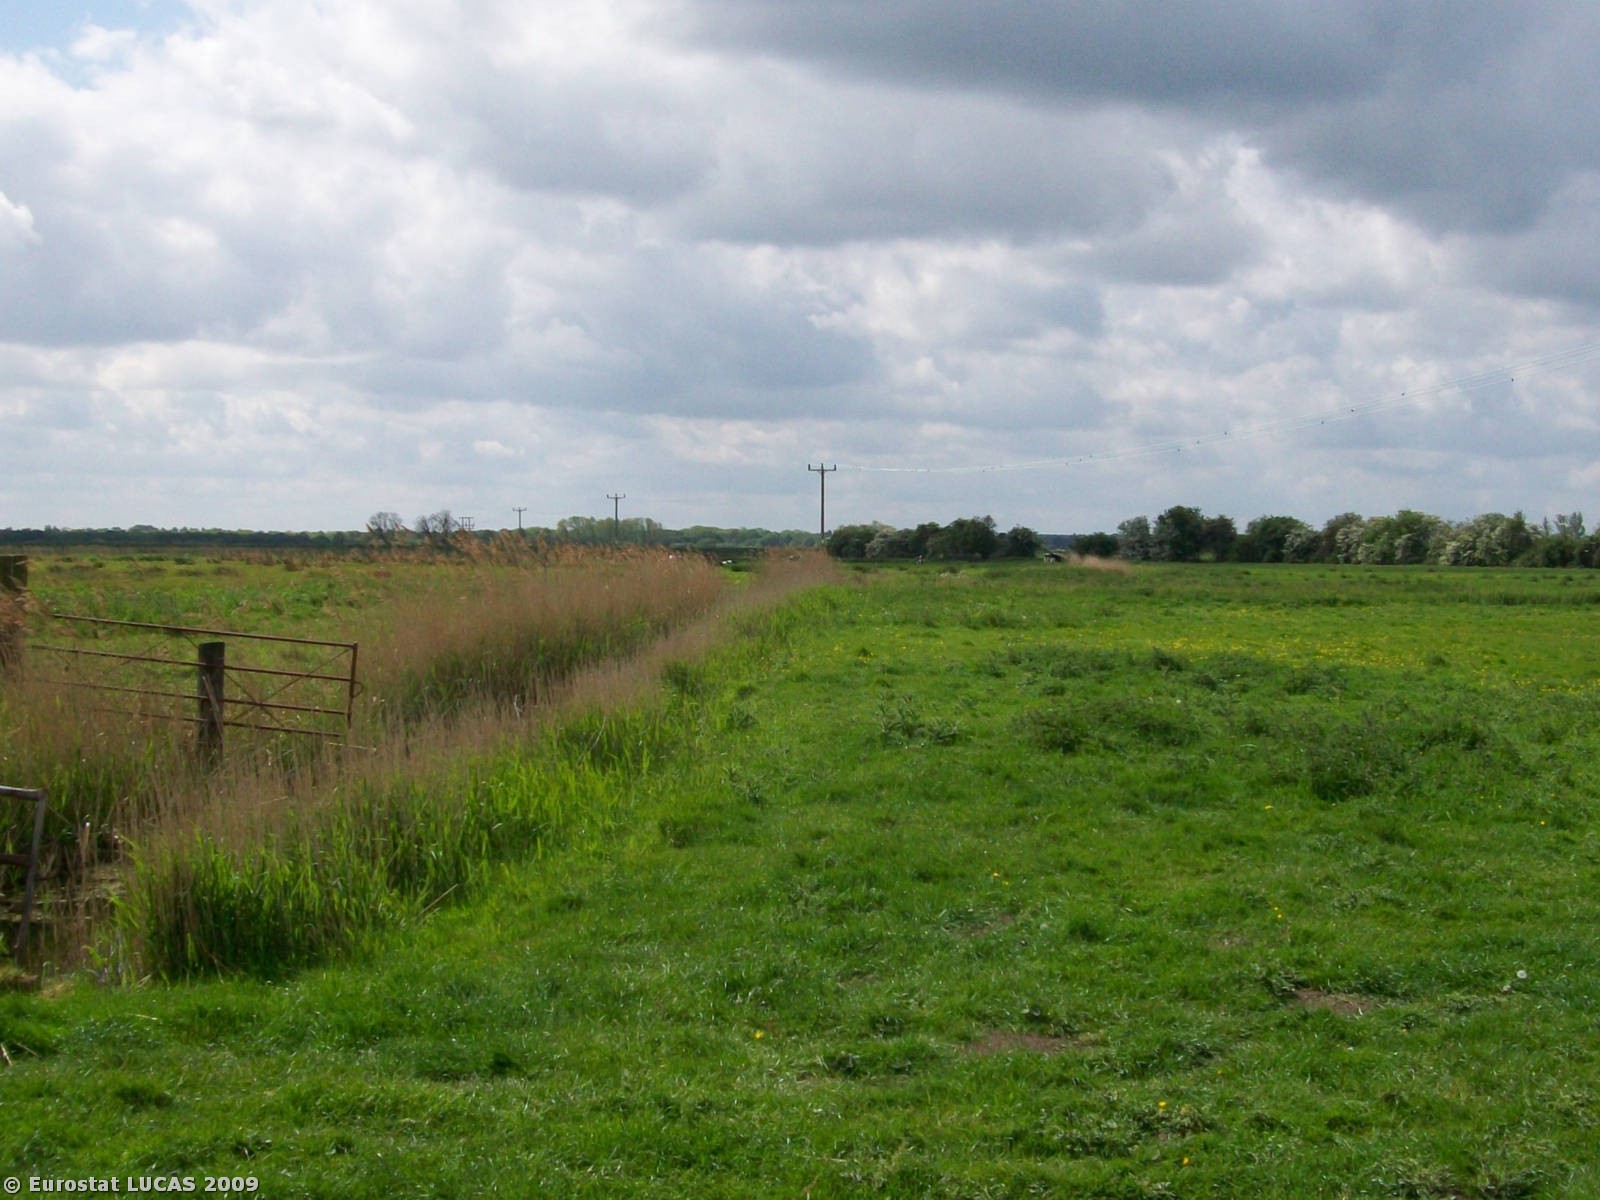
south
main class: Grassland
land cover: Grassland without tree/shrub cover
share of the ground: > 75 %
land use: Agriculture (excluding fallow land and kitchen gardens)
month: May
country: GB
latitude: 52.6893
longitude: 1.5336
